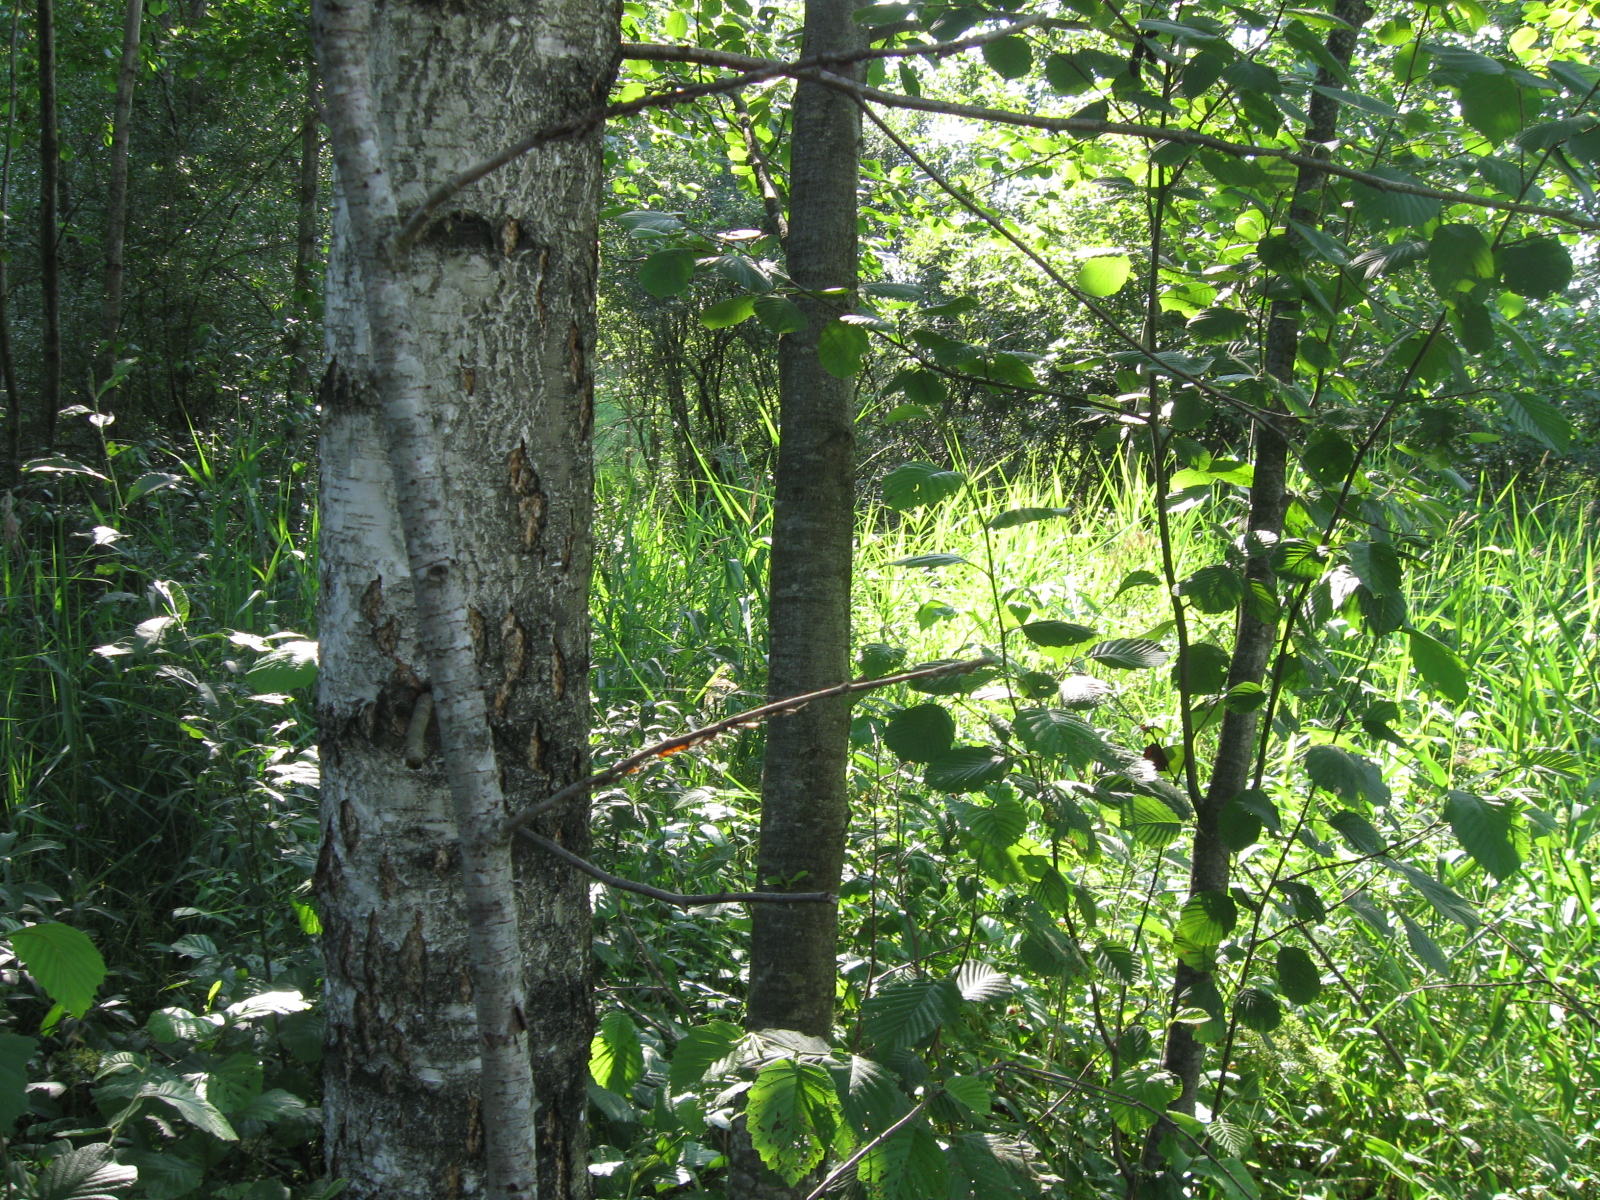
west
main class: Woodland
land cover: Broadleaved woodland
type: non-riverine alder, birch or aspen forest
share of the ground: > 75 %
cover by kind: broadleaved forest trees 90 %, herbaceous plants 10 %
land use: Forestry
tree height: > 5 m
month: July
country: LT
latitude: 54.4936
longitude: 24.3814
